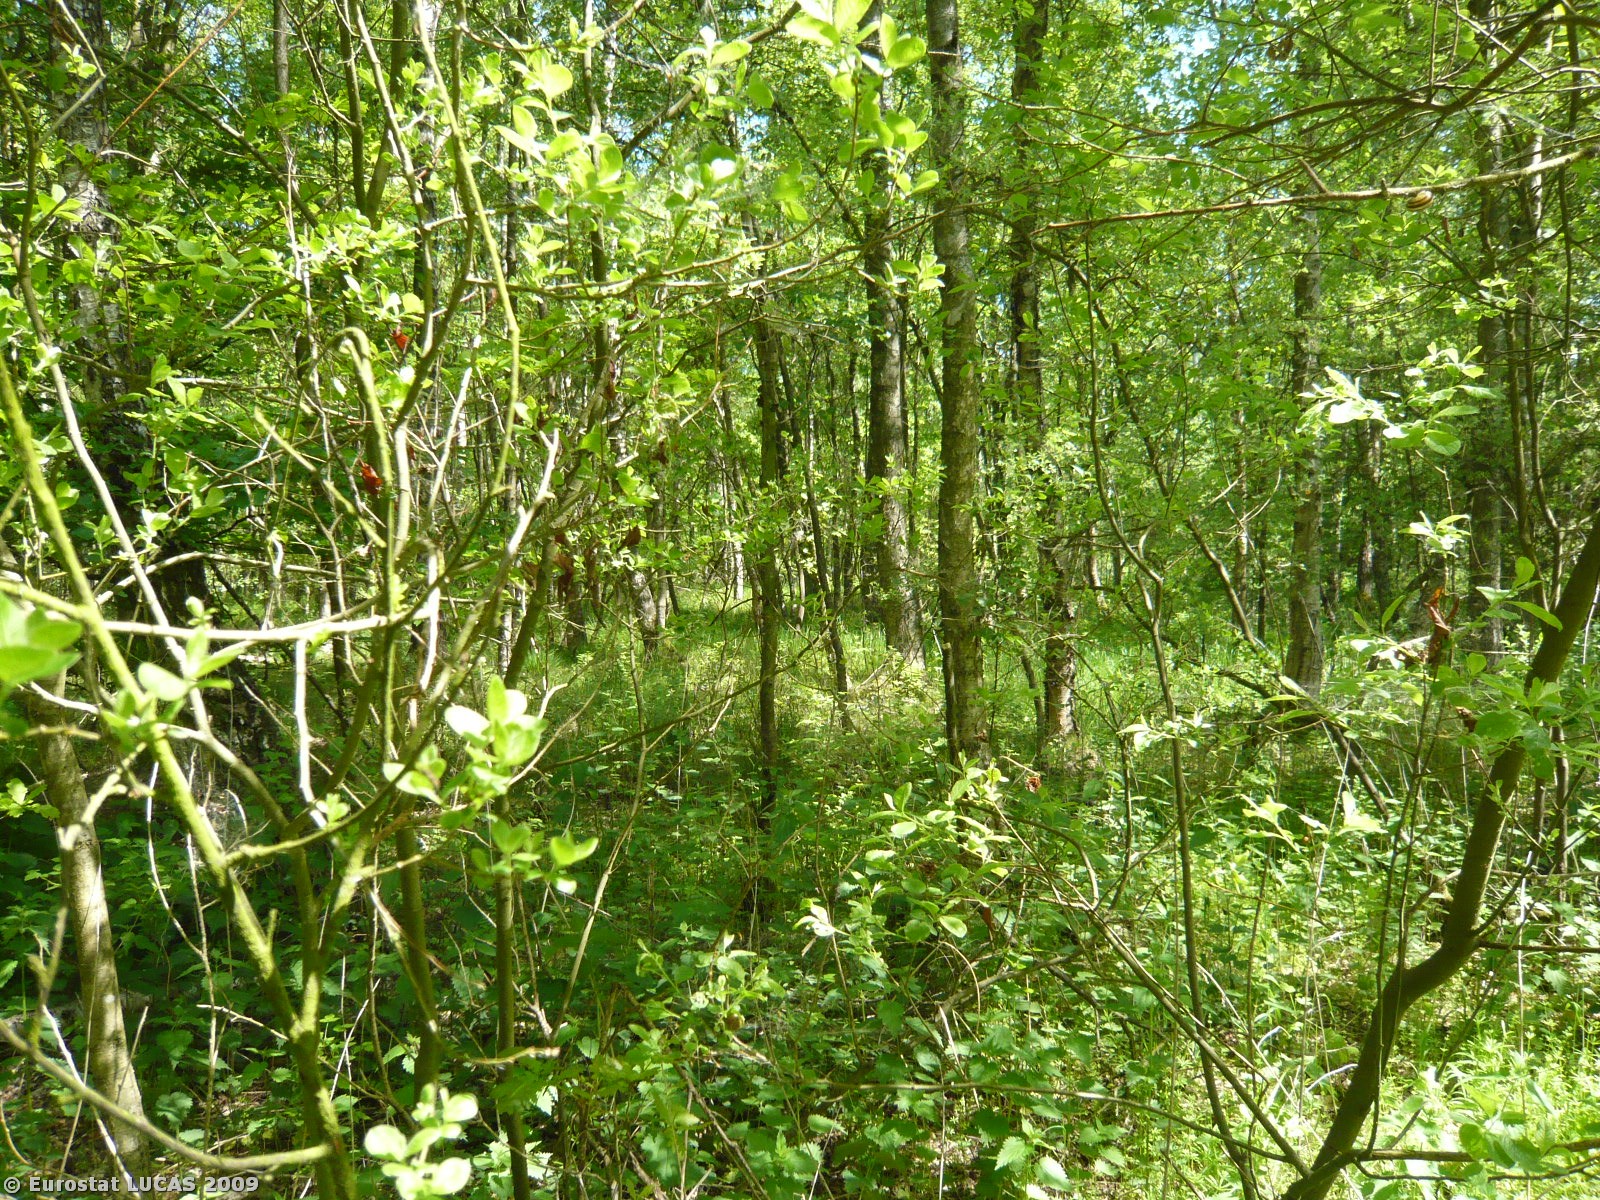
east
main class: Woodland
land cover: Broadleaved woodland
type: non-riverine alder, birch or aspen forest
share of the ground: > 75 %
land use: Forestry
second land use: Amenities, museums, leisure
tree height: > 5 m
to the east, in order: Broadleaved woodland; Inland water bodies; Mixed woodland; Grassland without tree/shrub cover; Ditches and canals; Grass margins; Common wheat
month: May
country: DK
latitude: 55.3124
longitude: 11.7790
